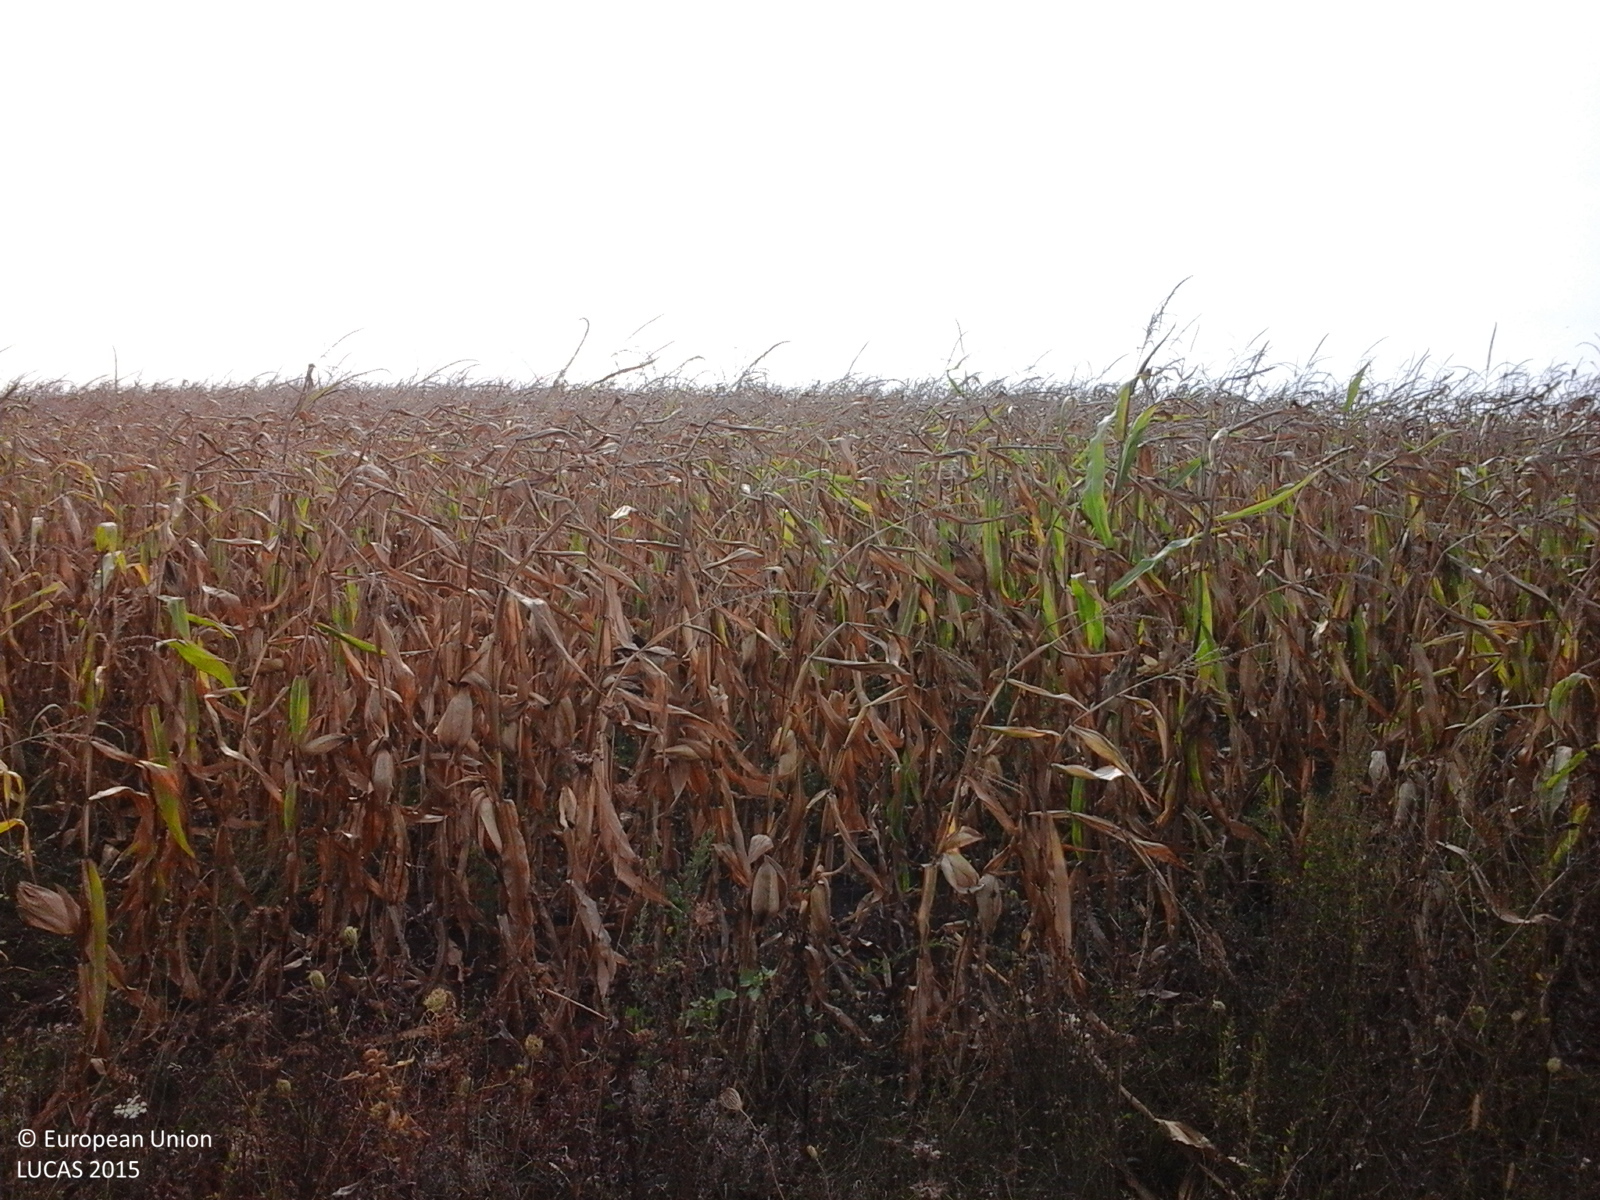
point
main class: Cropland
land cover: Maize
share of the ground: > 75 %
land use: Agriculture (excluding fallow land and kitchen gardens)
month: September
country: RO
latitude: 46.8731
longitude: 23.6789
